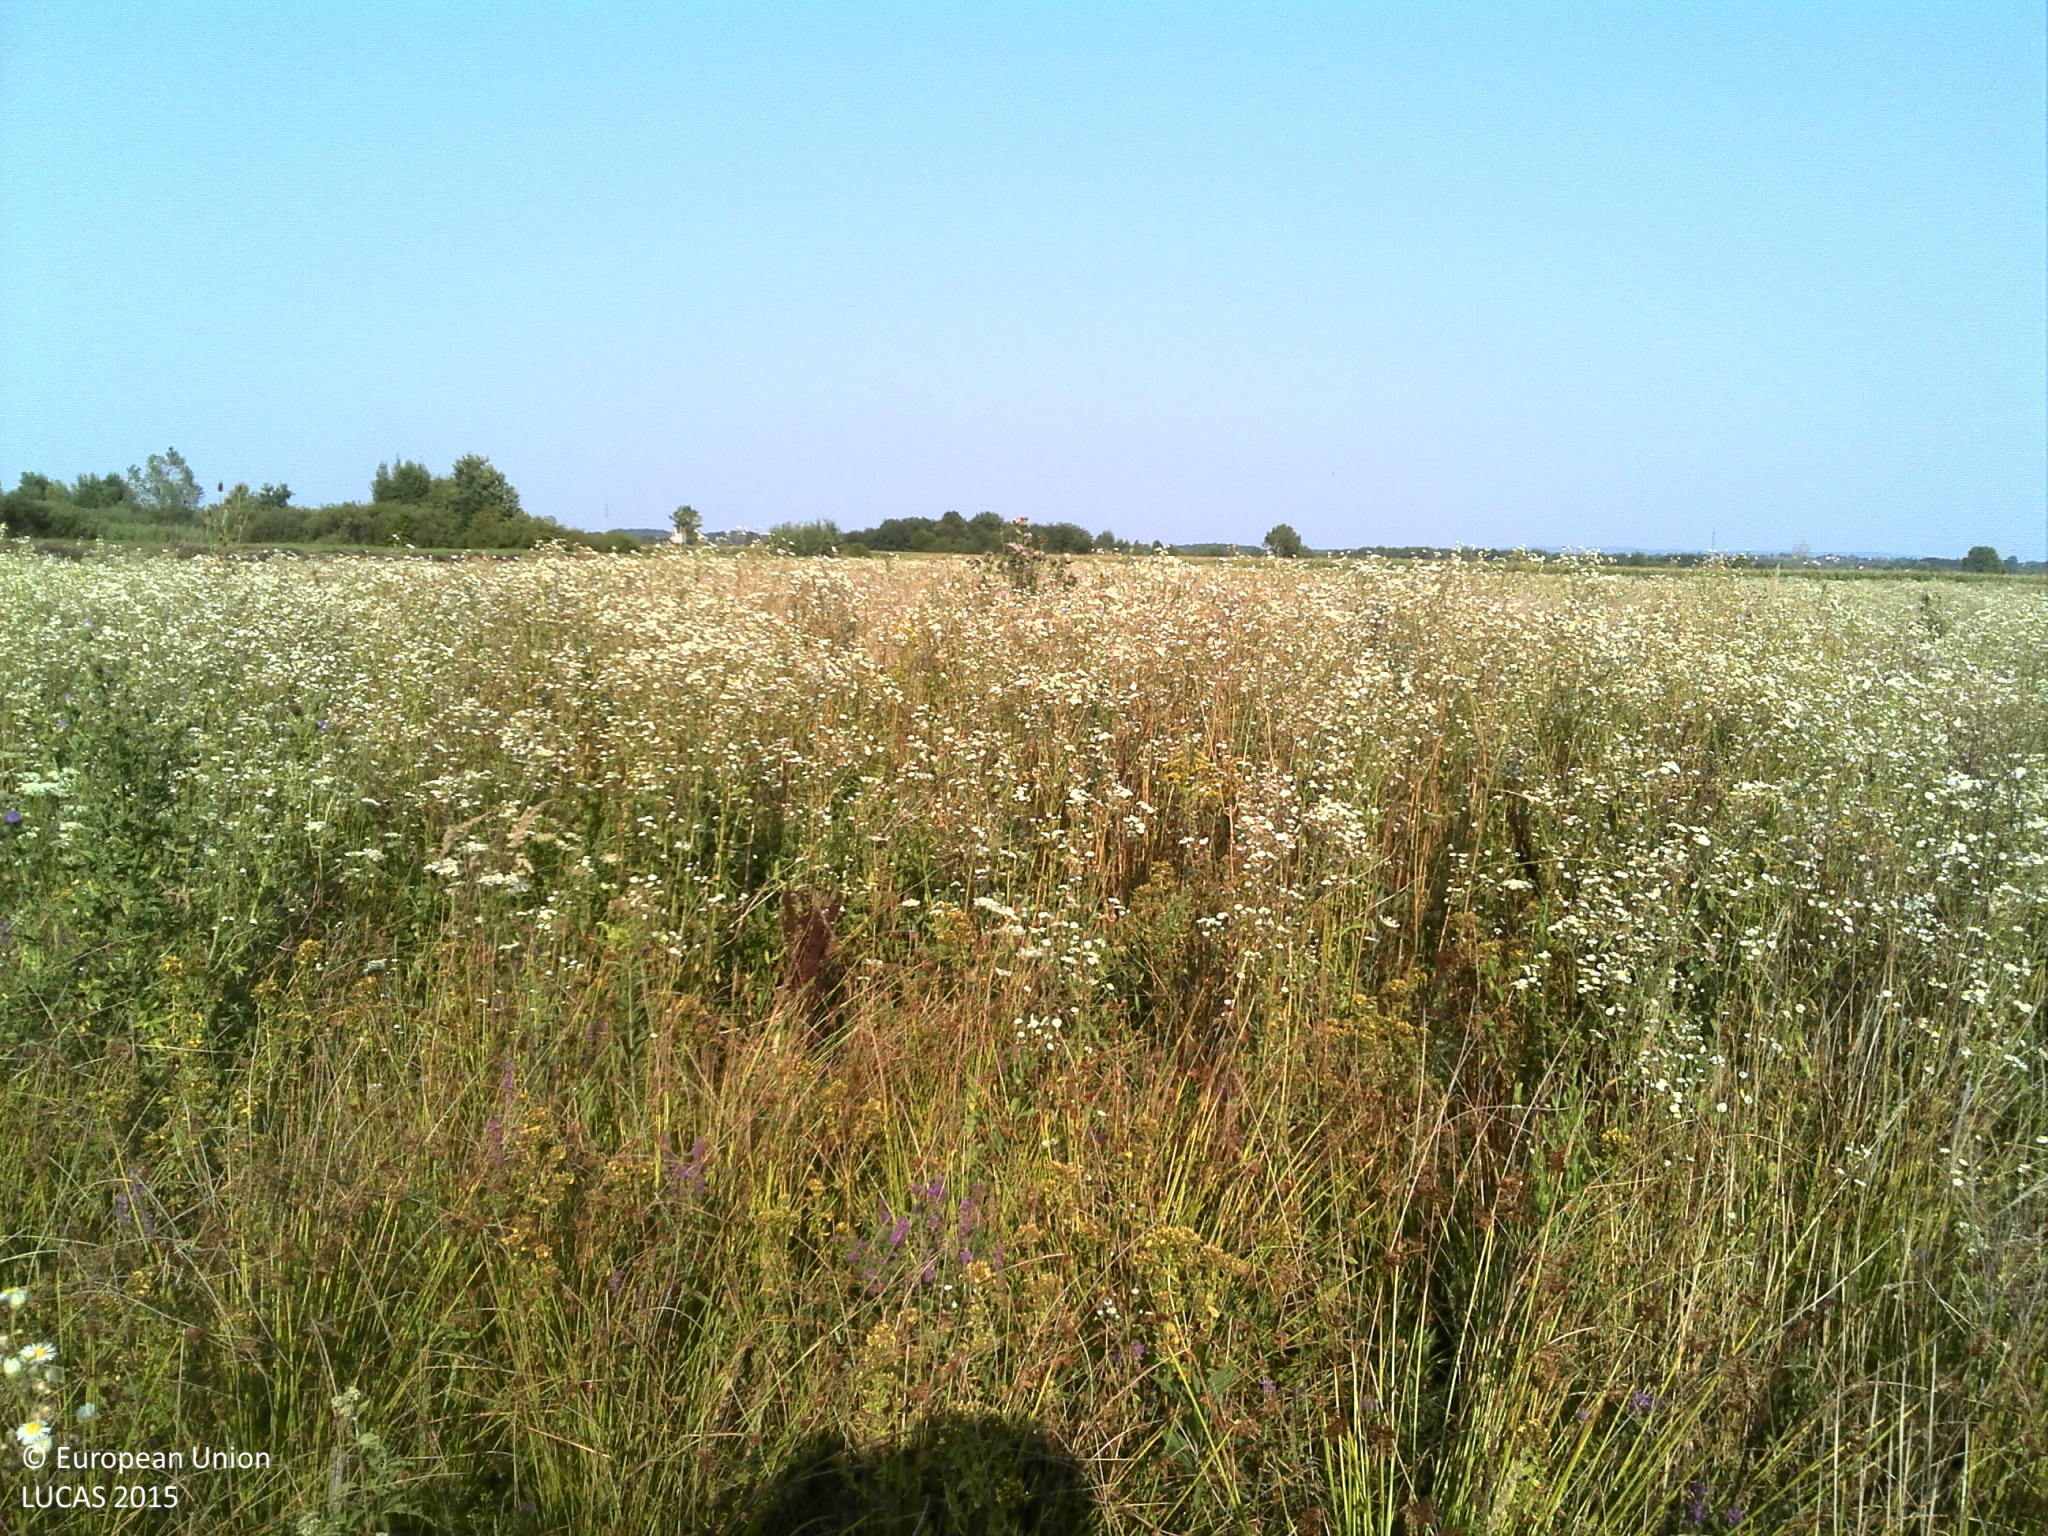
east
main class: Grassland
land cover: Spontaneously vegetated surfaces
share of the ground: > 75 %
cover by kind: herbaceous plants 100 %
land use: Fallow land
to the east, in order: Spontaneously vegetated surfaces; Tracks; Ditches and canals; Spontaneously vegetated surfaces; Maize
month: August
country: HR
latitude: 45.6862
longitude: 16.4572
